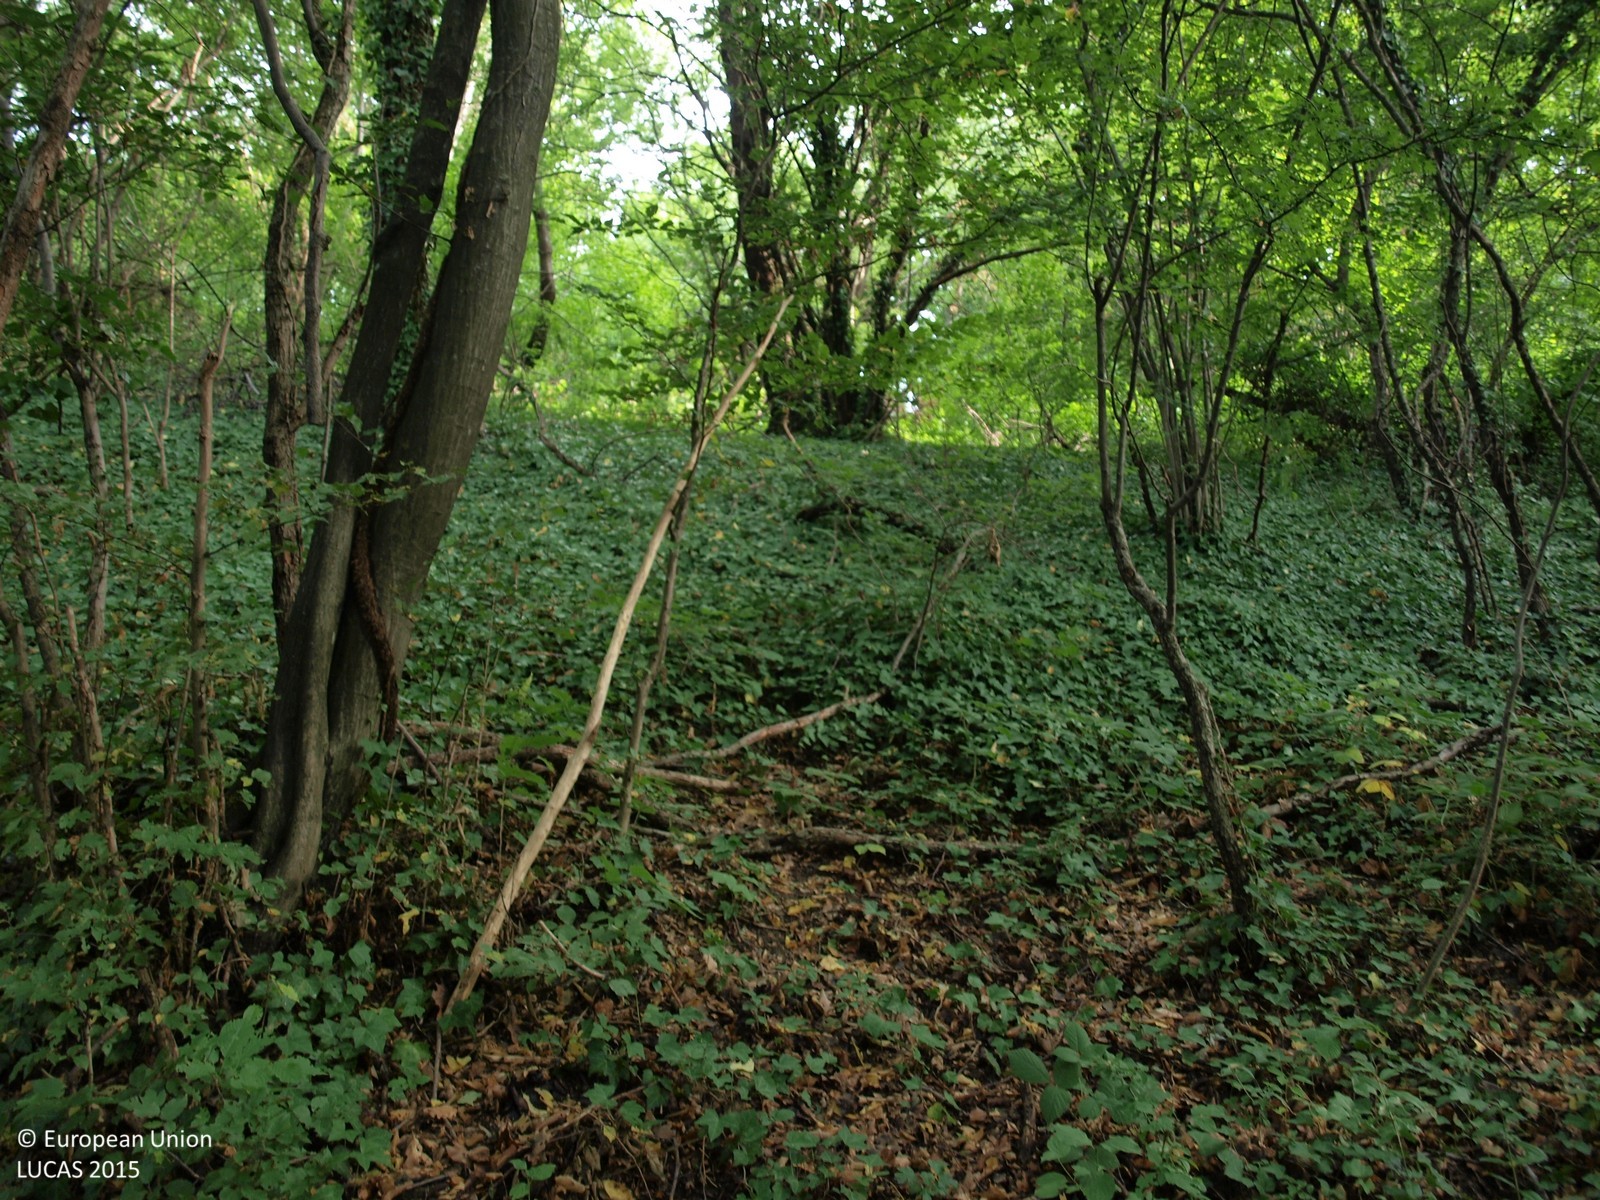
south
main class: Woodland
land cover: Broadleaved woodland
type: mesophytic deciduous forest
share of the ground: > 75 %
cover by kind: broadleaved forest trees 100 %
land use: Forestry
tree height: > 5 m
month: July
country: HR
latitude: 46.1082
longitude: 16.3520
